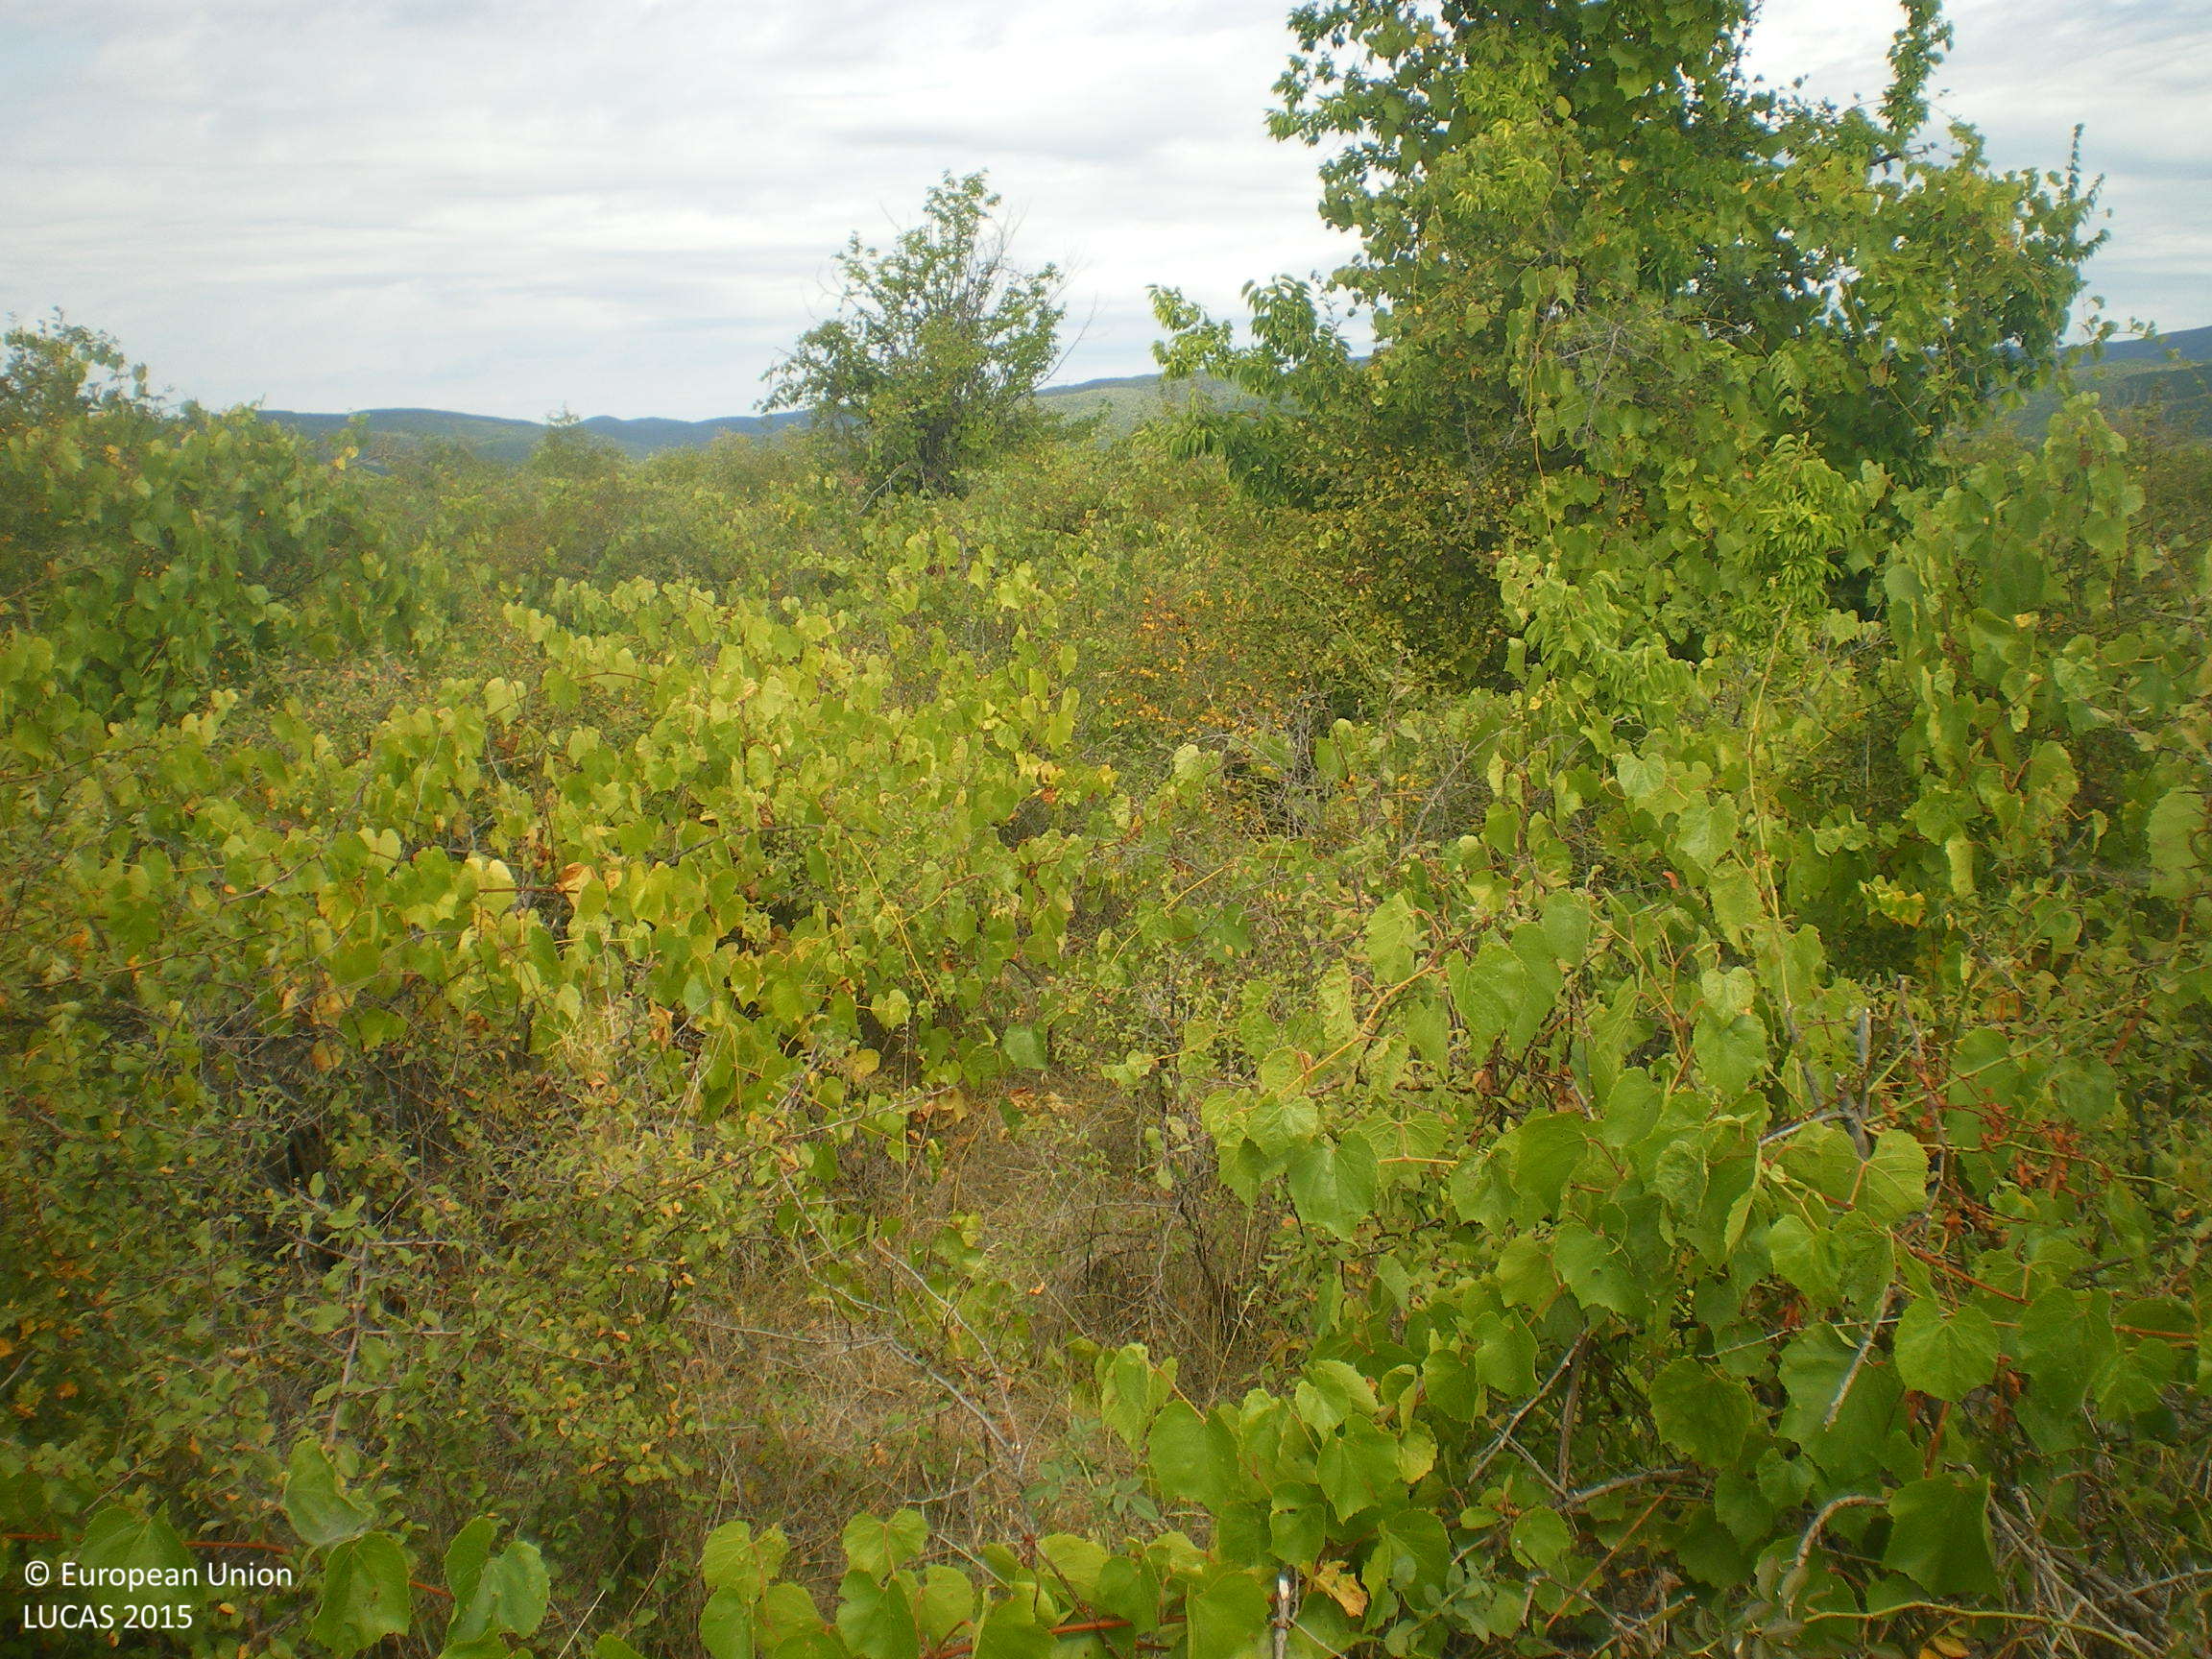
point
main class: Cropland
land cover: Vineyards
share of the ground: > 75 %
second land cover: Shrubland without tree cover
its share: > 75 %
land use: Abandoned areas
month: September
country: BG
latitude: 42.4595
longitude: 25.7500
